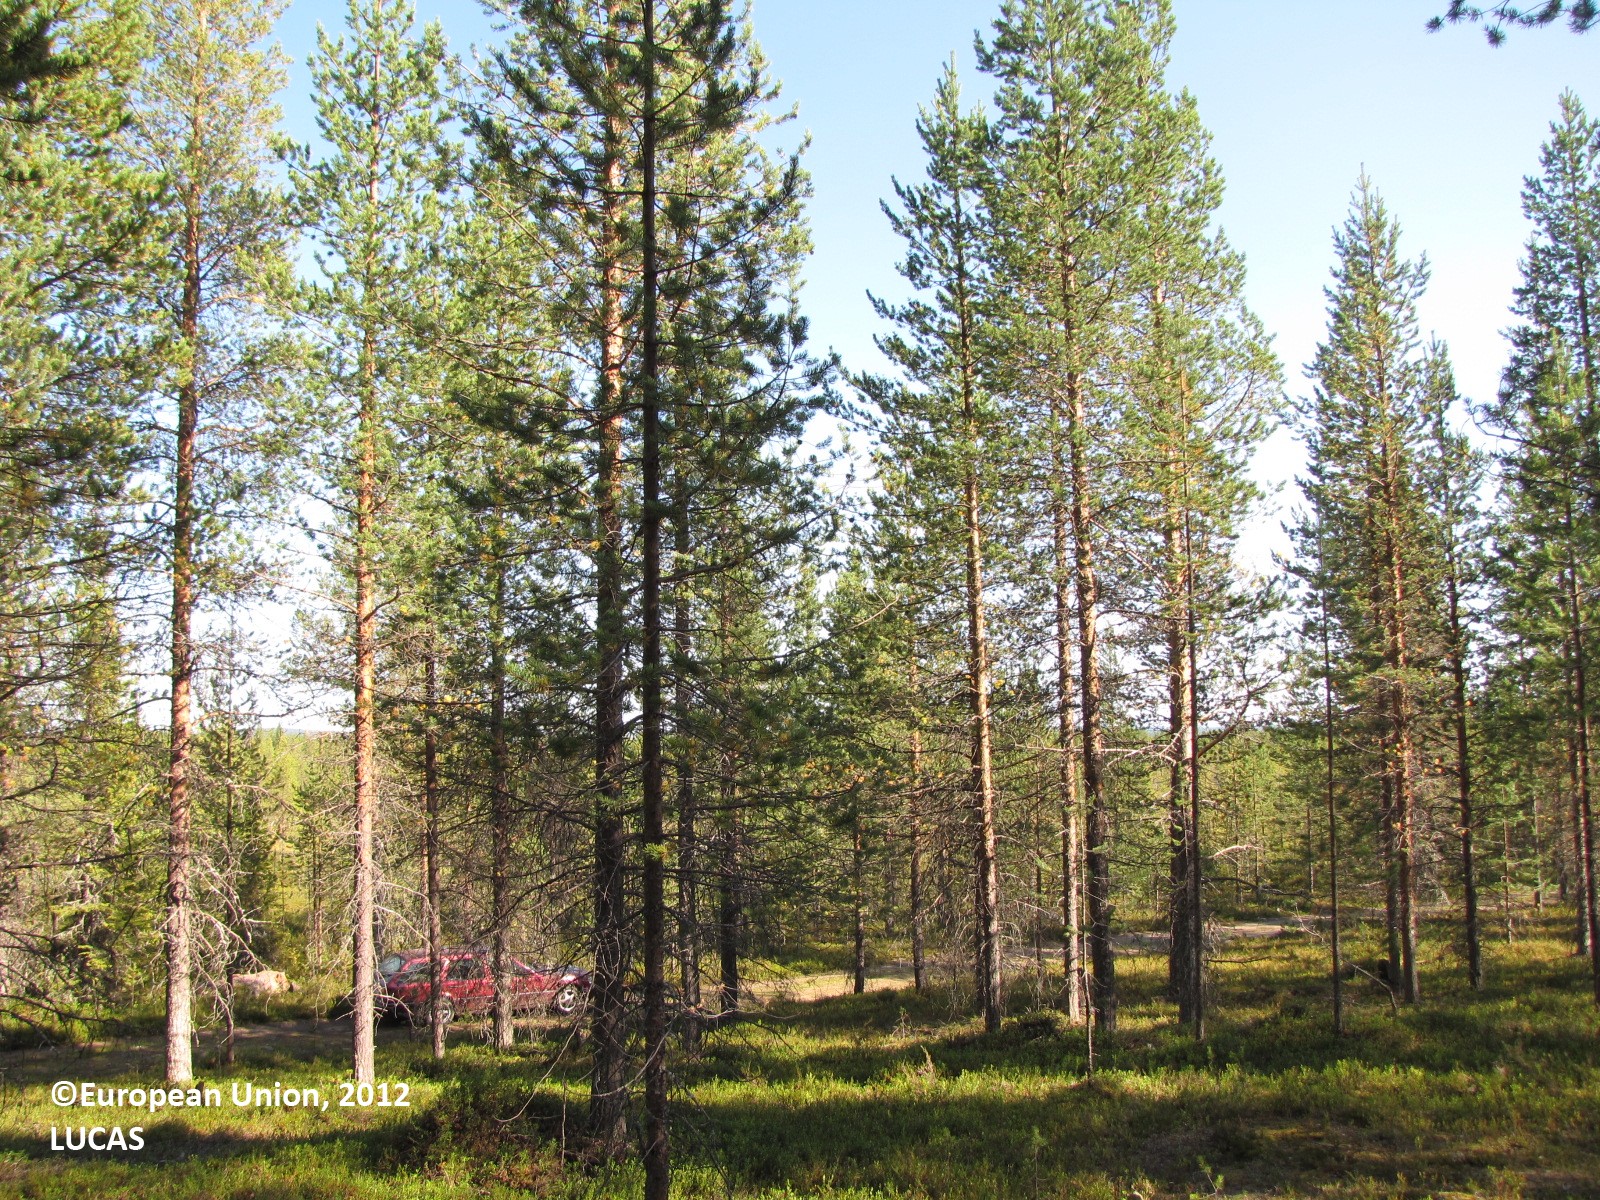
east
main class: Woodland
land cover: Pine dominated coniferous woodland
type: boreal forest
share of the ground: 25 - 50 %
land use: Forestry
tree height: > 5 m
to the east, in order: Pine dominated coniferous woodland; Paved roads, cycling and walking lanes; Pine dominated coniferous woodland; Peatbogs; Pine dominated coniferous woodland
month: August
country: FI
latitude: 67.0071
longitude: 25.2150
